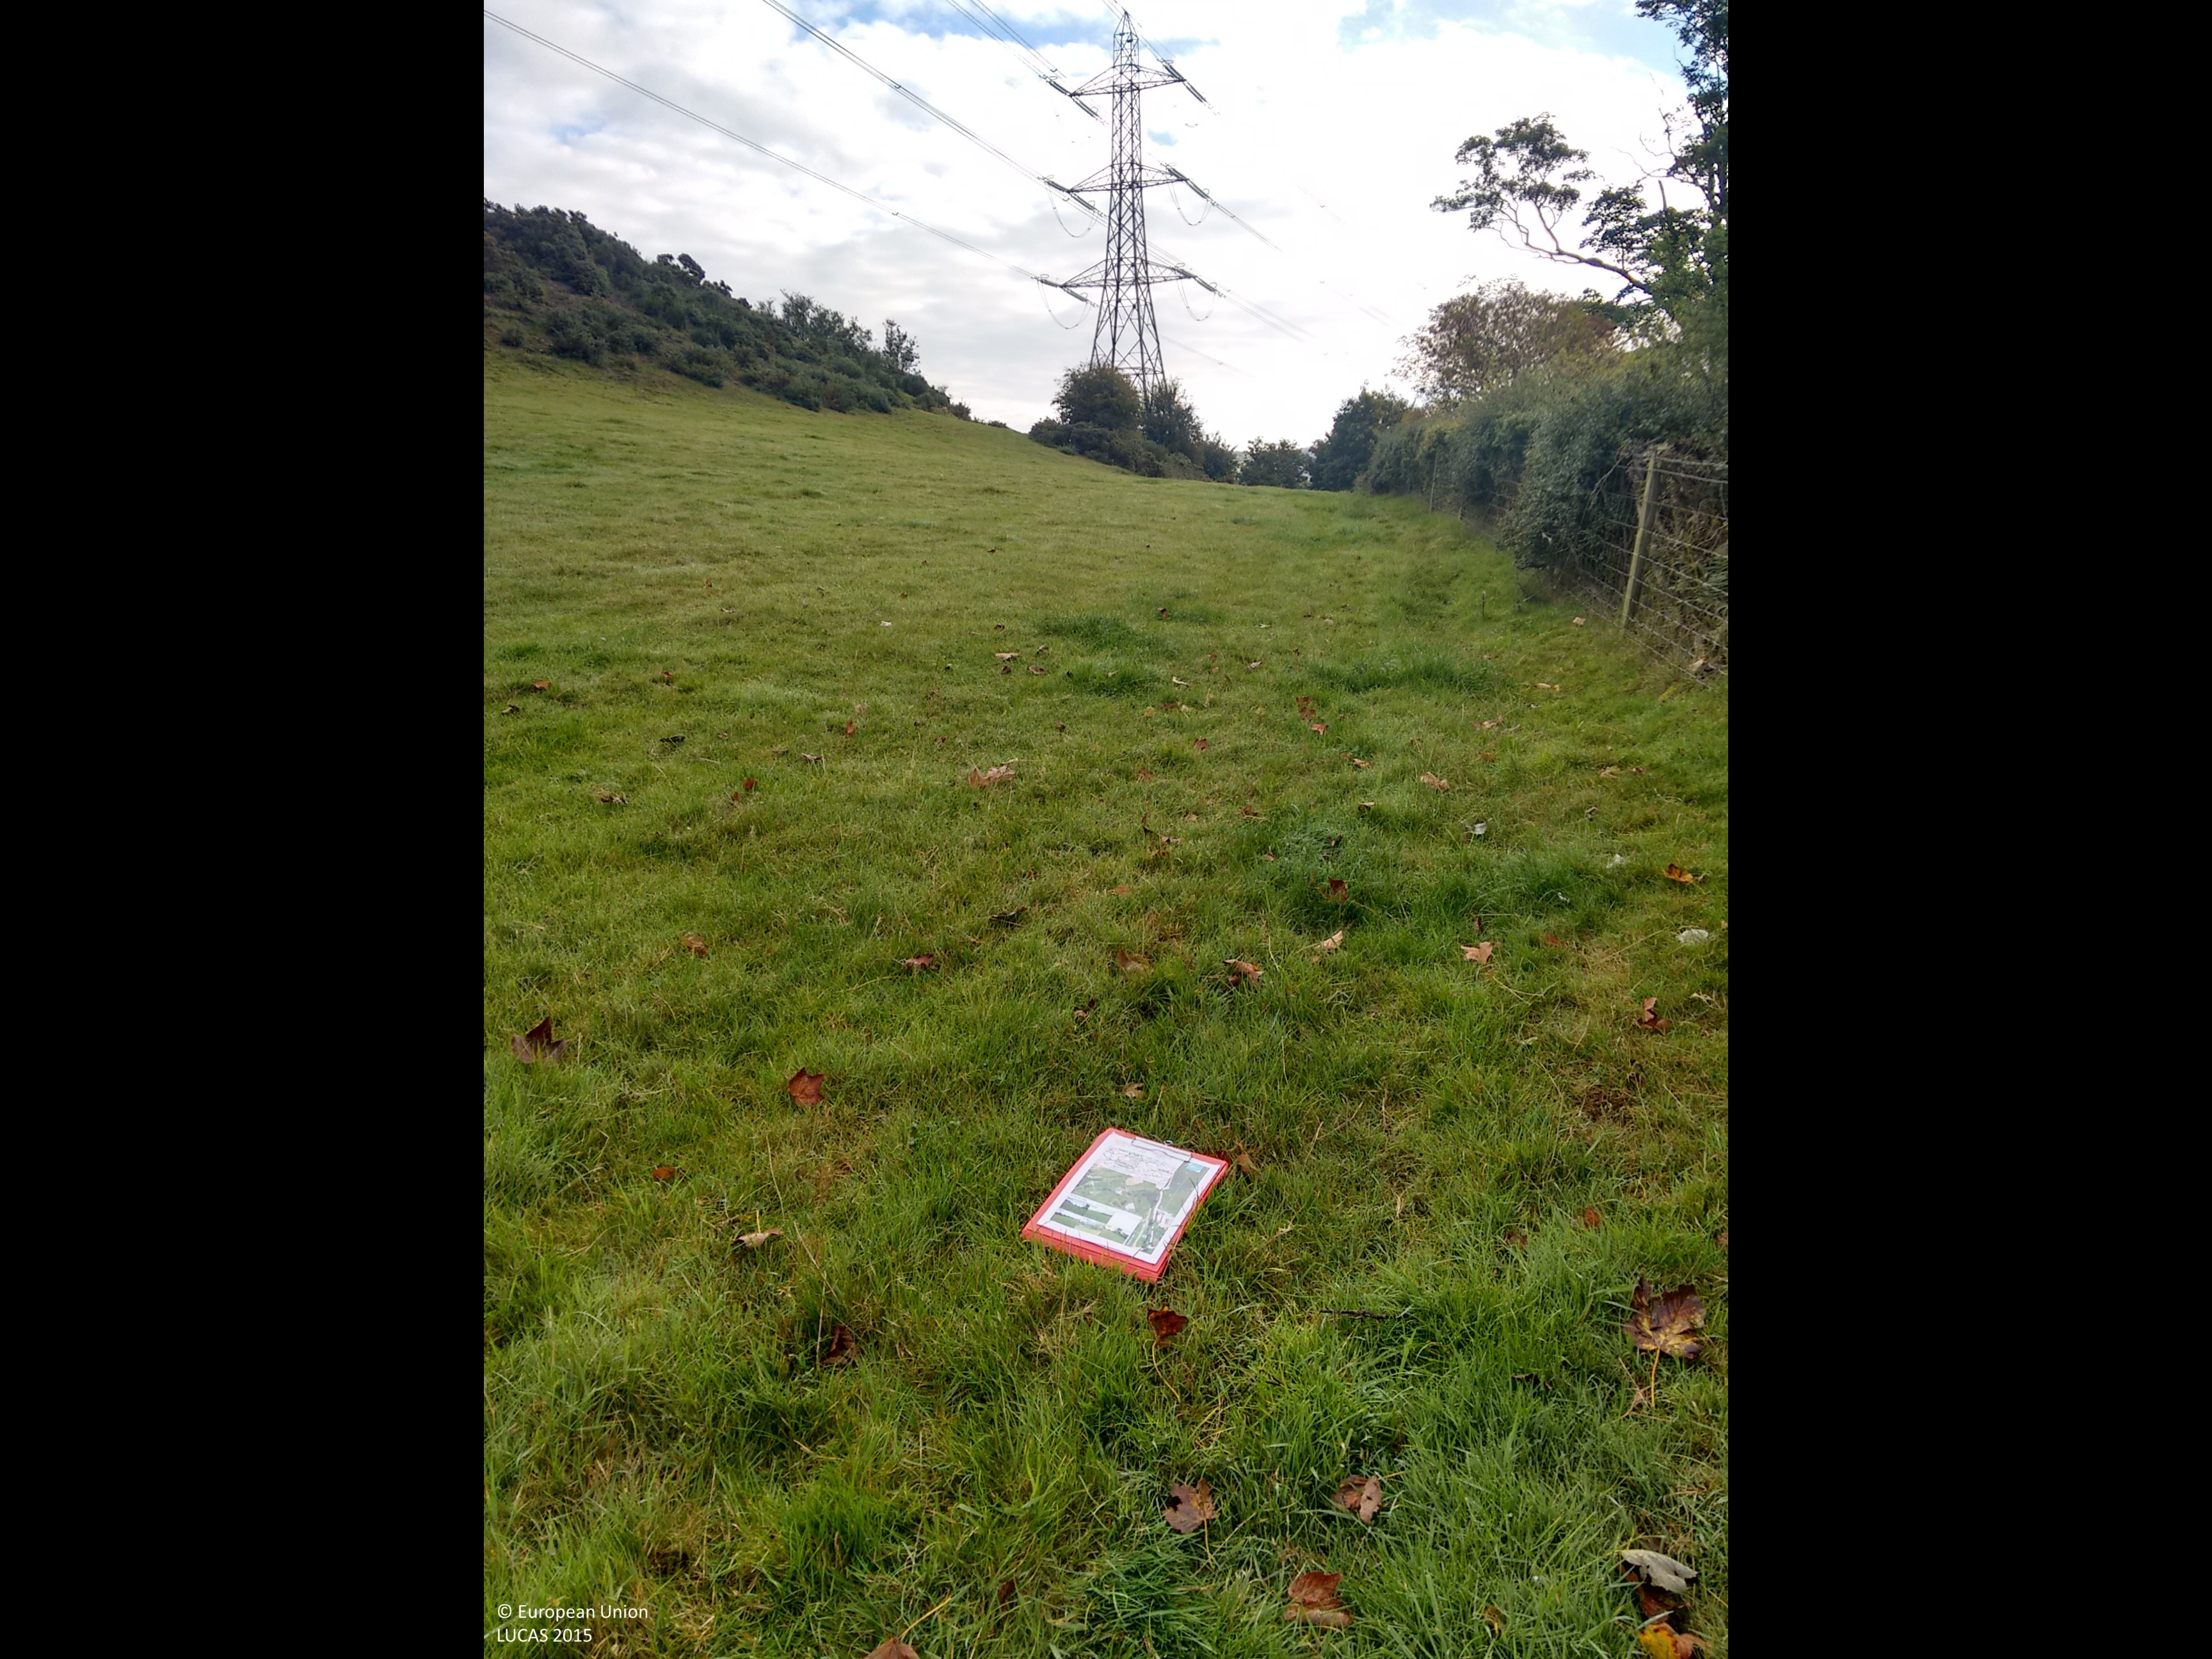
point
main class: Grassland
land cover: Grassland without tree/shrub cover
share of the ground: > 75 %
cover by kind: herbaceous plants 100 %
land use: Agriculture (excluding fallow land and kitchen gardens)
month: September
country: GB
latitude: 53.0038
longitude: -3.3590
